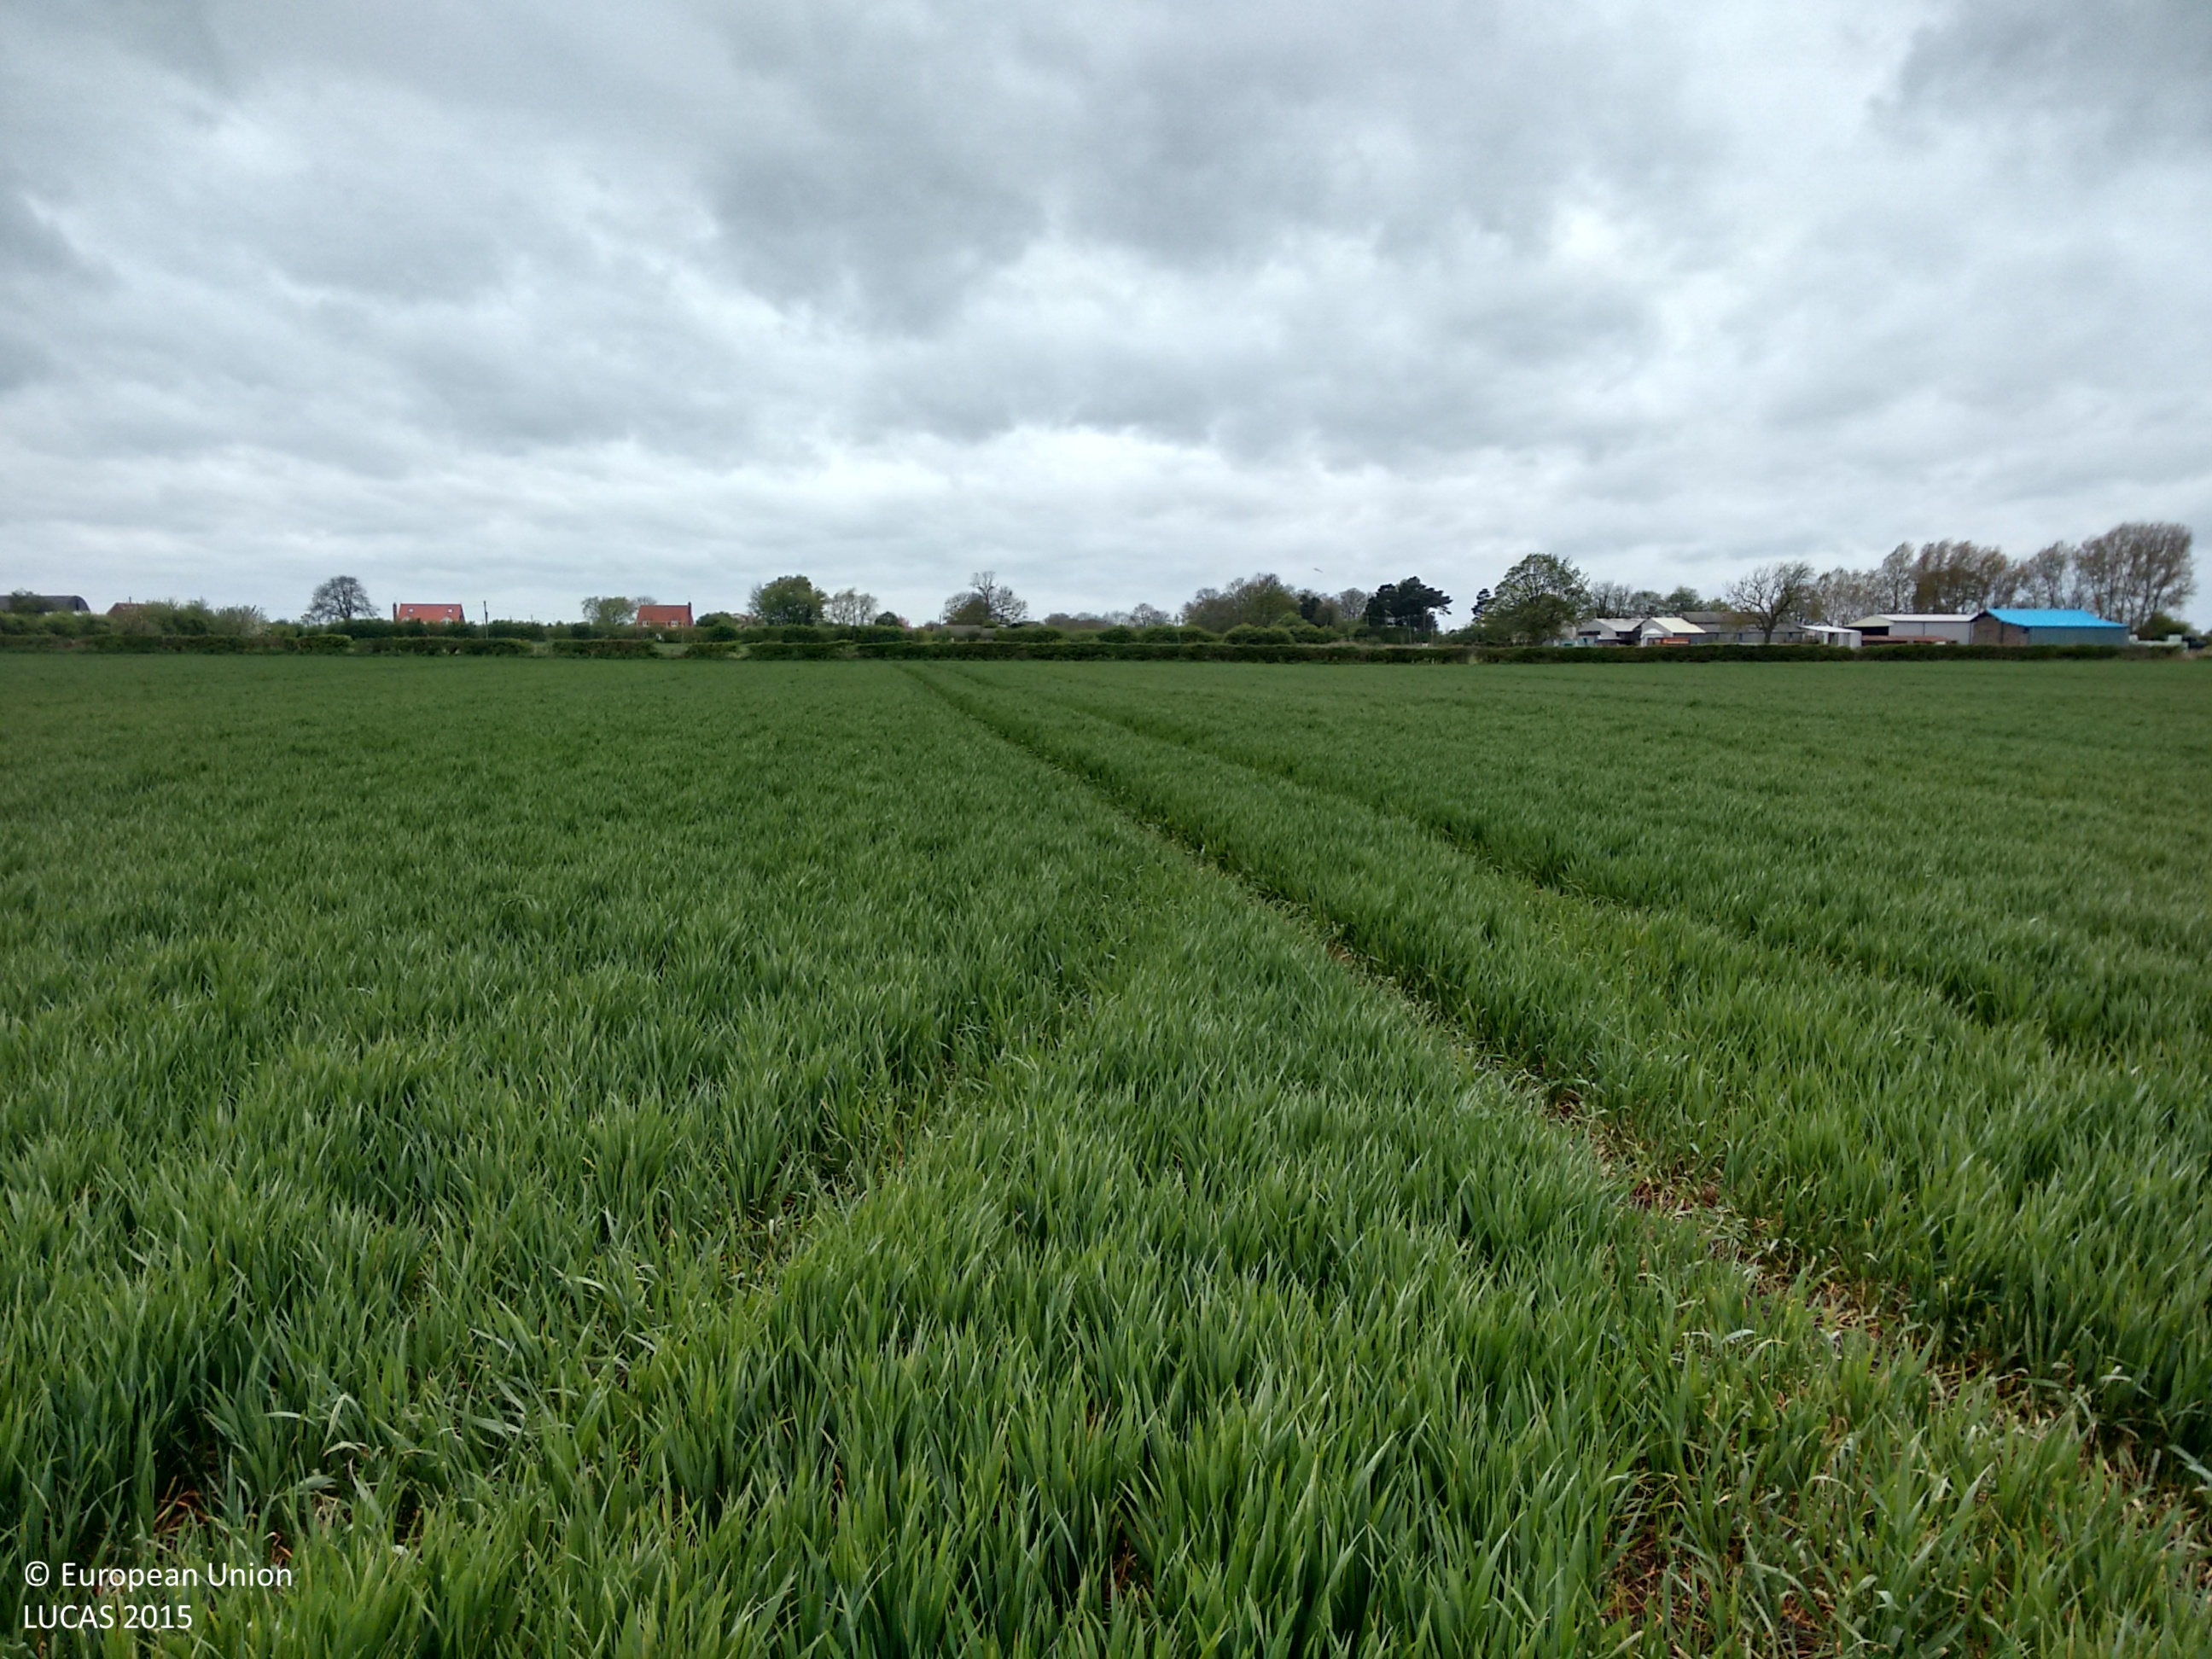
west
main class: Cropland
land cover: Barley
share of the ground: > 75 %
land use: Agriculture (excluding fallow land and kitchen gardens)
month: May
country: GB
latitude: 53.7784
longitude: -0.7075
